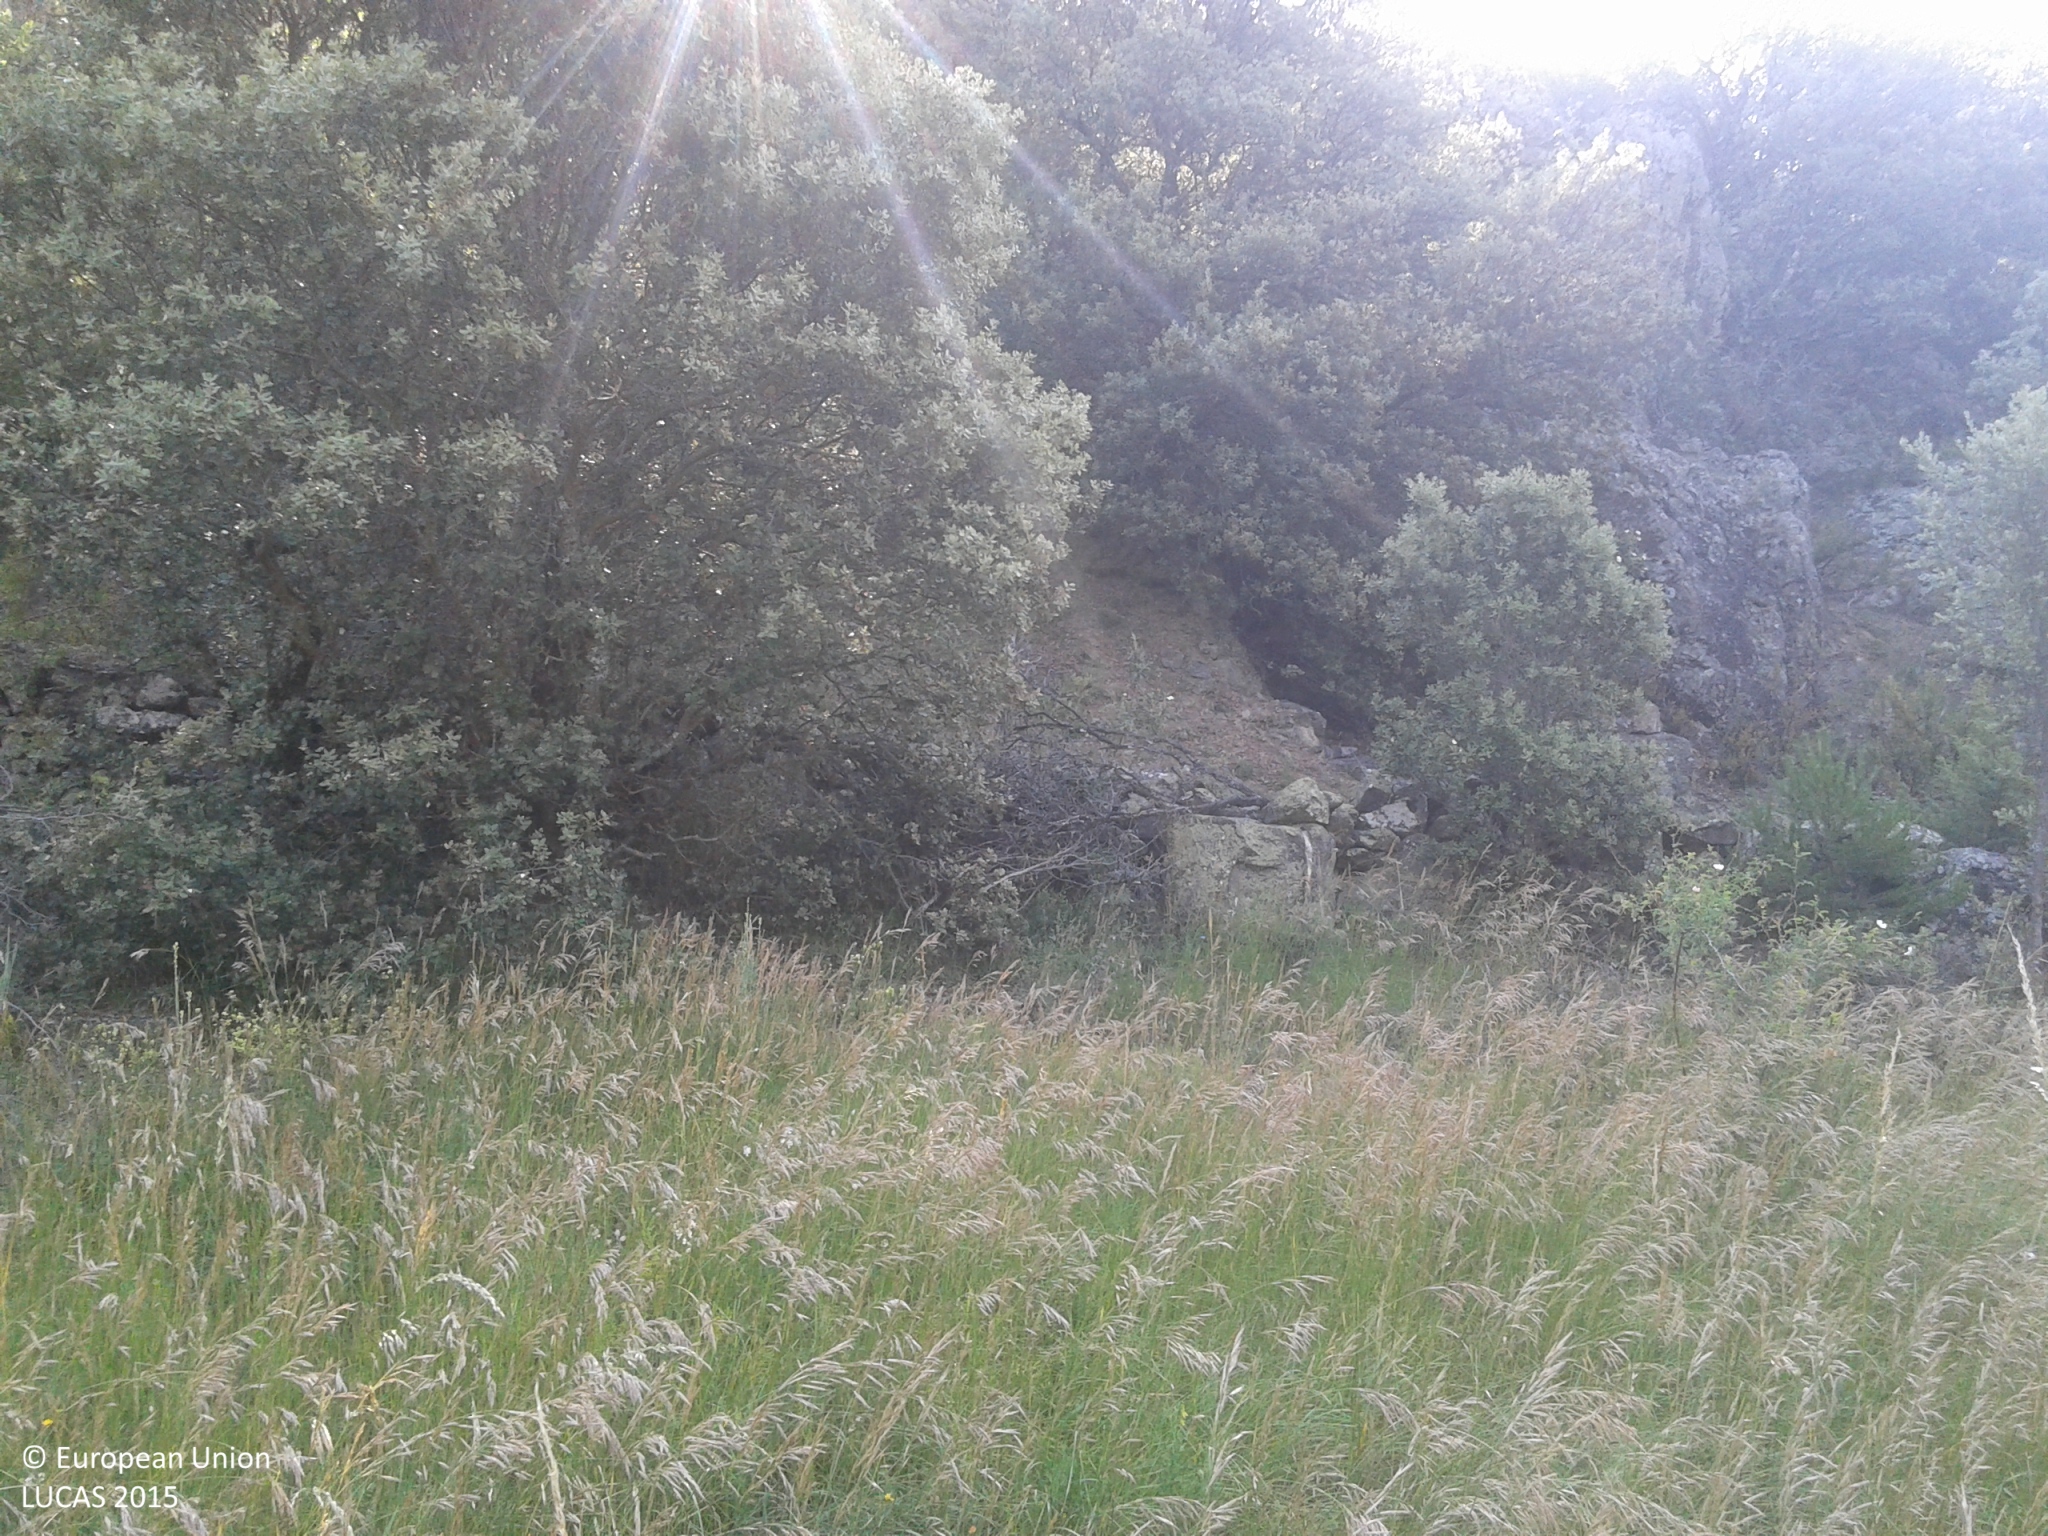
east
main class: Woodland
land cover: Pine dominated coniferous woodland
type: alpine coniferous forest
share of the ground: 25 - 50 %
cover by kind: shrubs 50 %, coniferous forest trees 30 %, unconsolidated bare surface 10 %, herbaceous plants 5 %, consolidated bare surface 5 %
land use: Semi-natural and natural areas not in use
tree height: > 5 m
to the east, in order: Pine dominated coniferous woodland; Rivers and streams; Other mixed woodland; Shrubland with sparse tree cover; Other mixed woodland
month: June
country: ES
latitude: 42.3886
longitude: 1.5193
